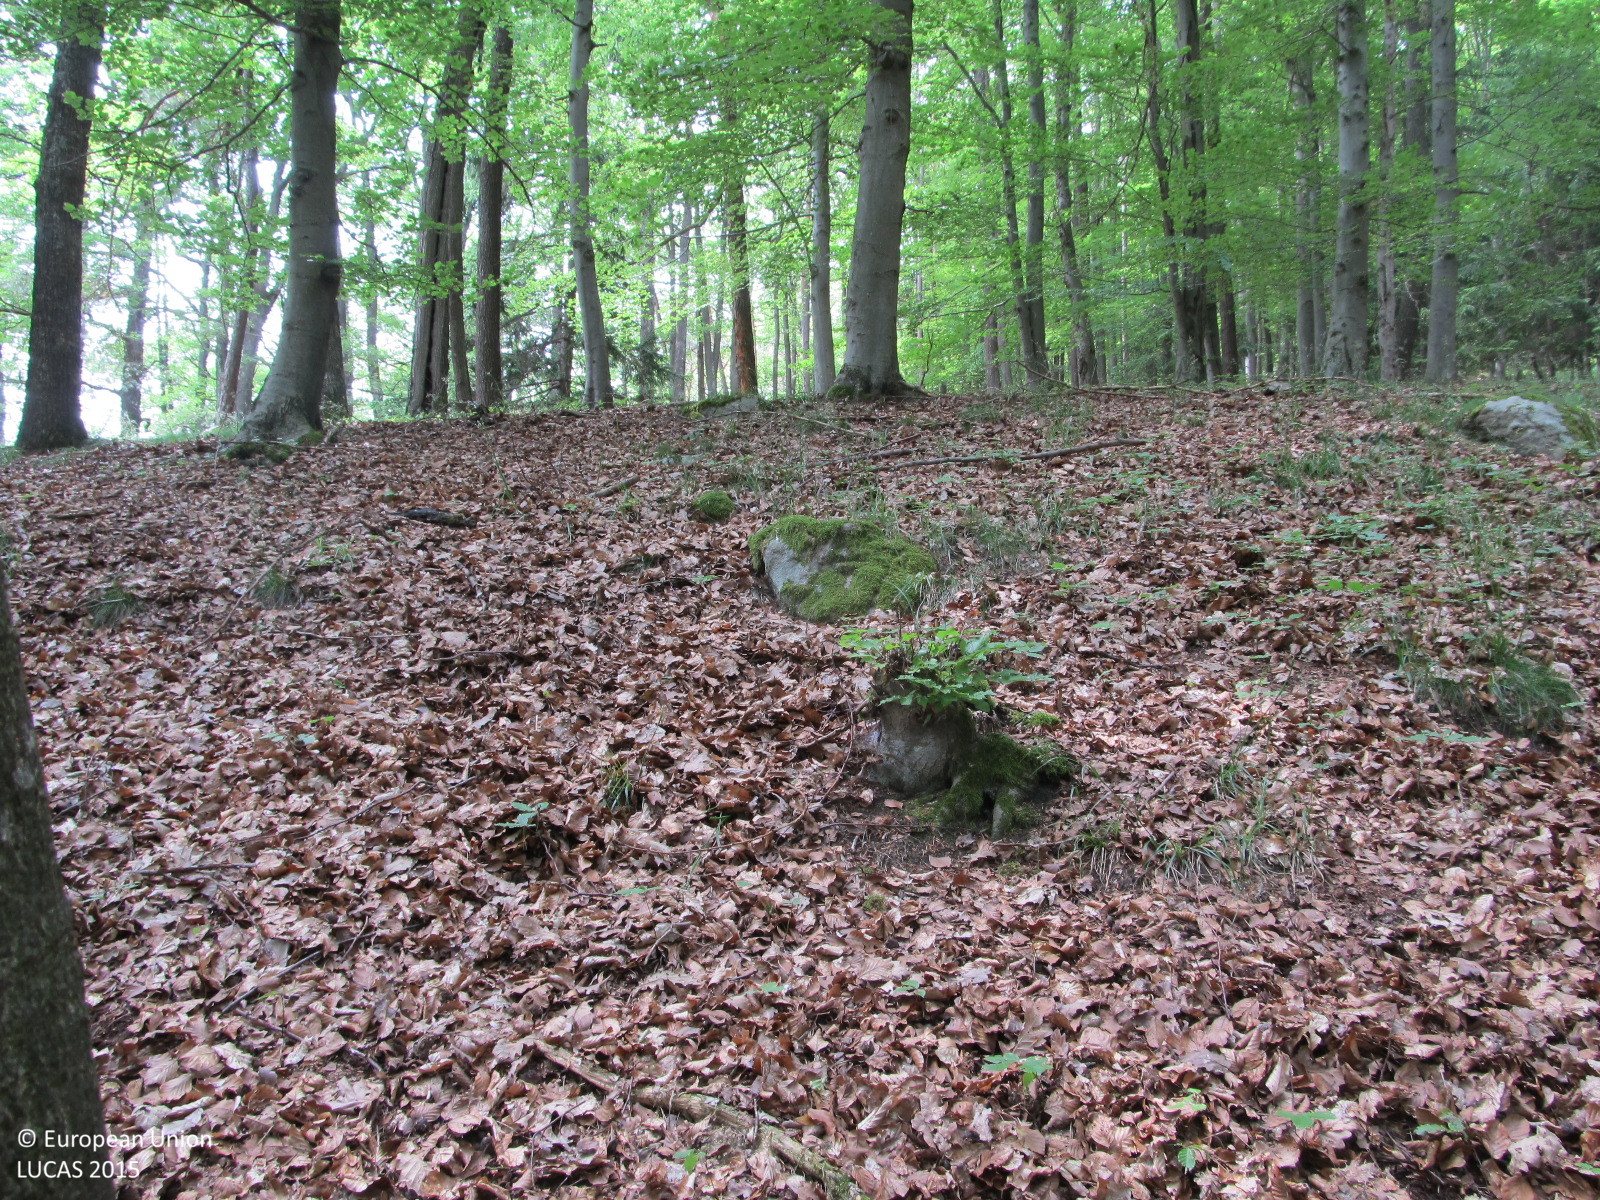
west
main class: Woodland
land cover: Broadleaved woodland
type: beech forest
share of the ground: > 75 %
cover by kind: broadleaved forest trees 60 %, coniferous forest trees 20 %, unconsolidated bare surface 20 %
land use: Forestry
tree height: > 5 m
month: June
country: AT
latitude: 48.4135
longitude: 15.4473
